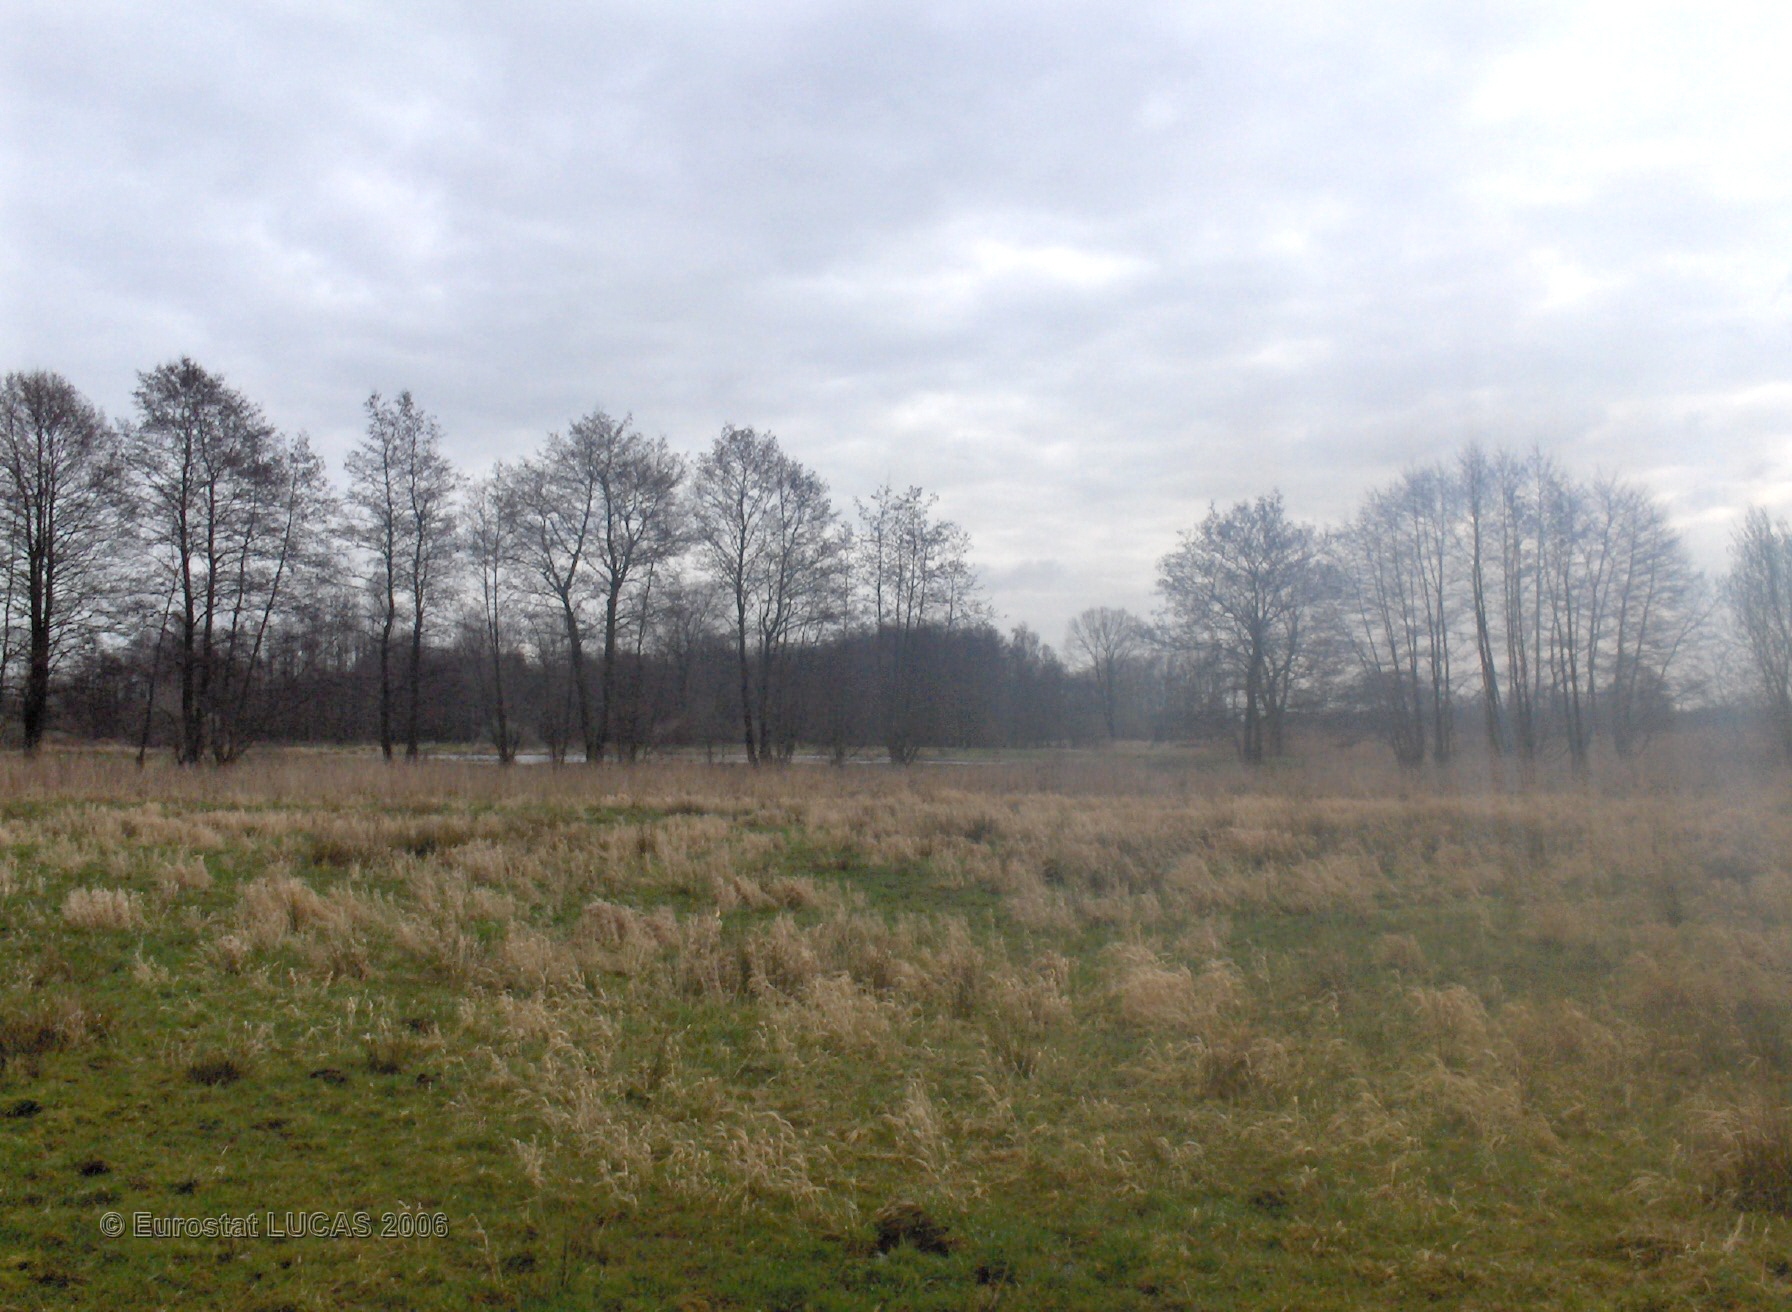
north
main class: Grassland
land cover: Grassland without tree/shrub cover
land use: Amenities, museums, leisure
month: March
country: BE
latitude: 51.1451
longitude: 5.1803
